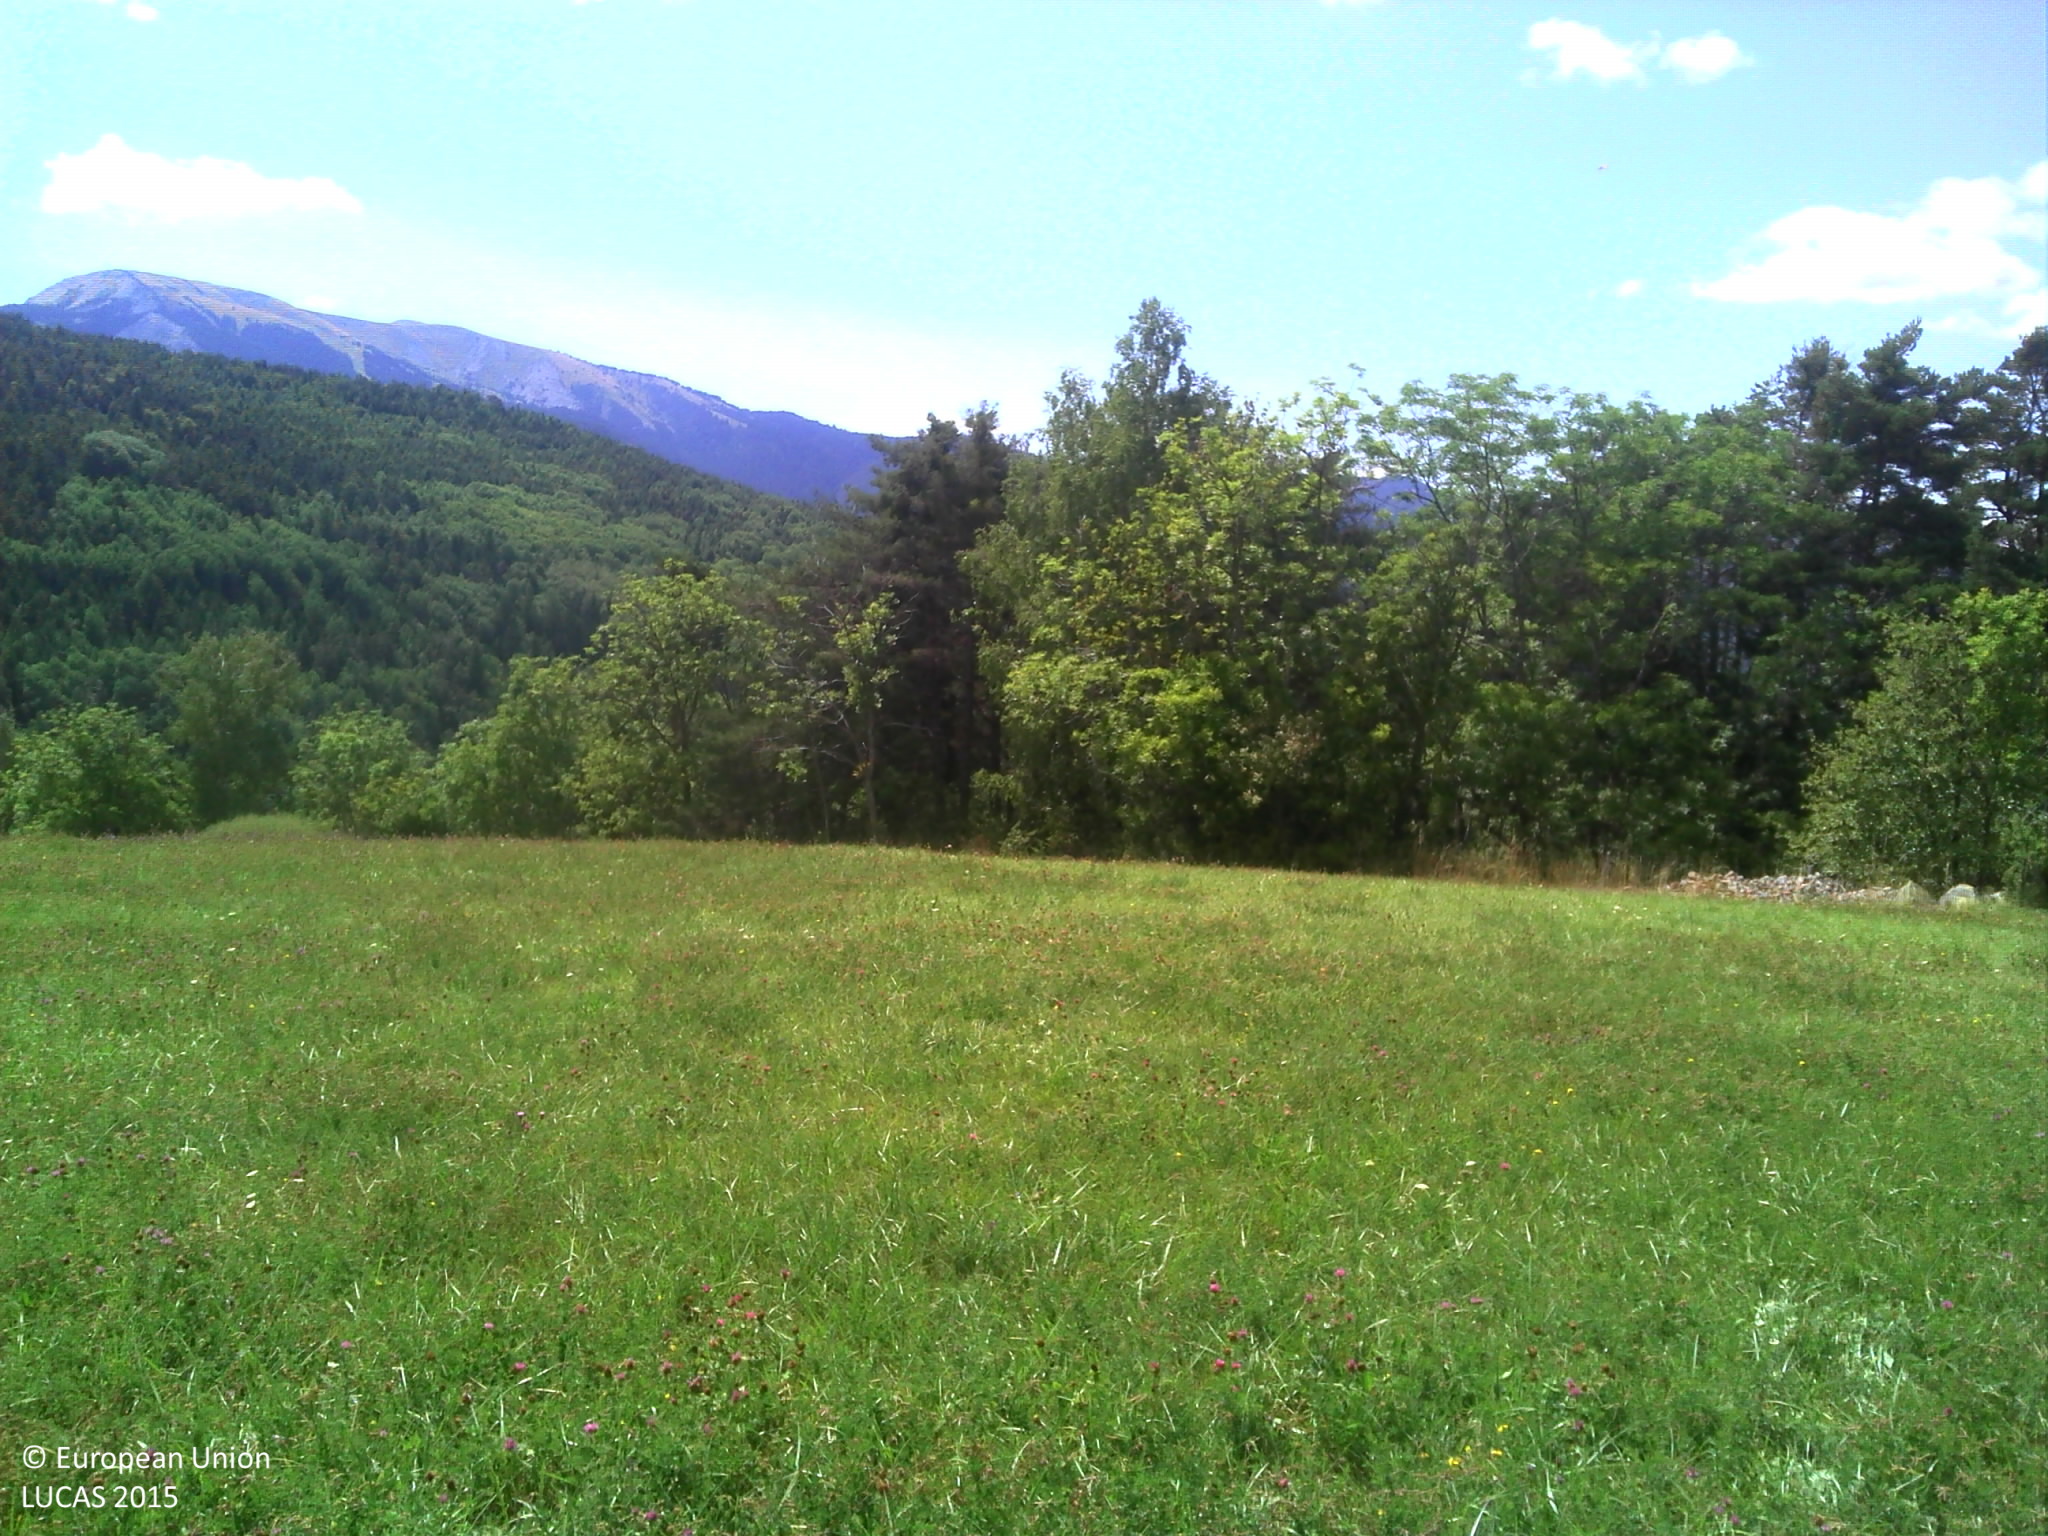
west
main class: Grassland
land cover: Grassland without tree/shrub cover
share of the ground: > 75 %
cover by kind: herbaceous plants 100 %
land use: Agriculture (excluding fallow land and kitchen gardens)
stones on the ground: < 10 %
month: August
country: FR
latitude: 44.3768
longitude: 6.3546
